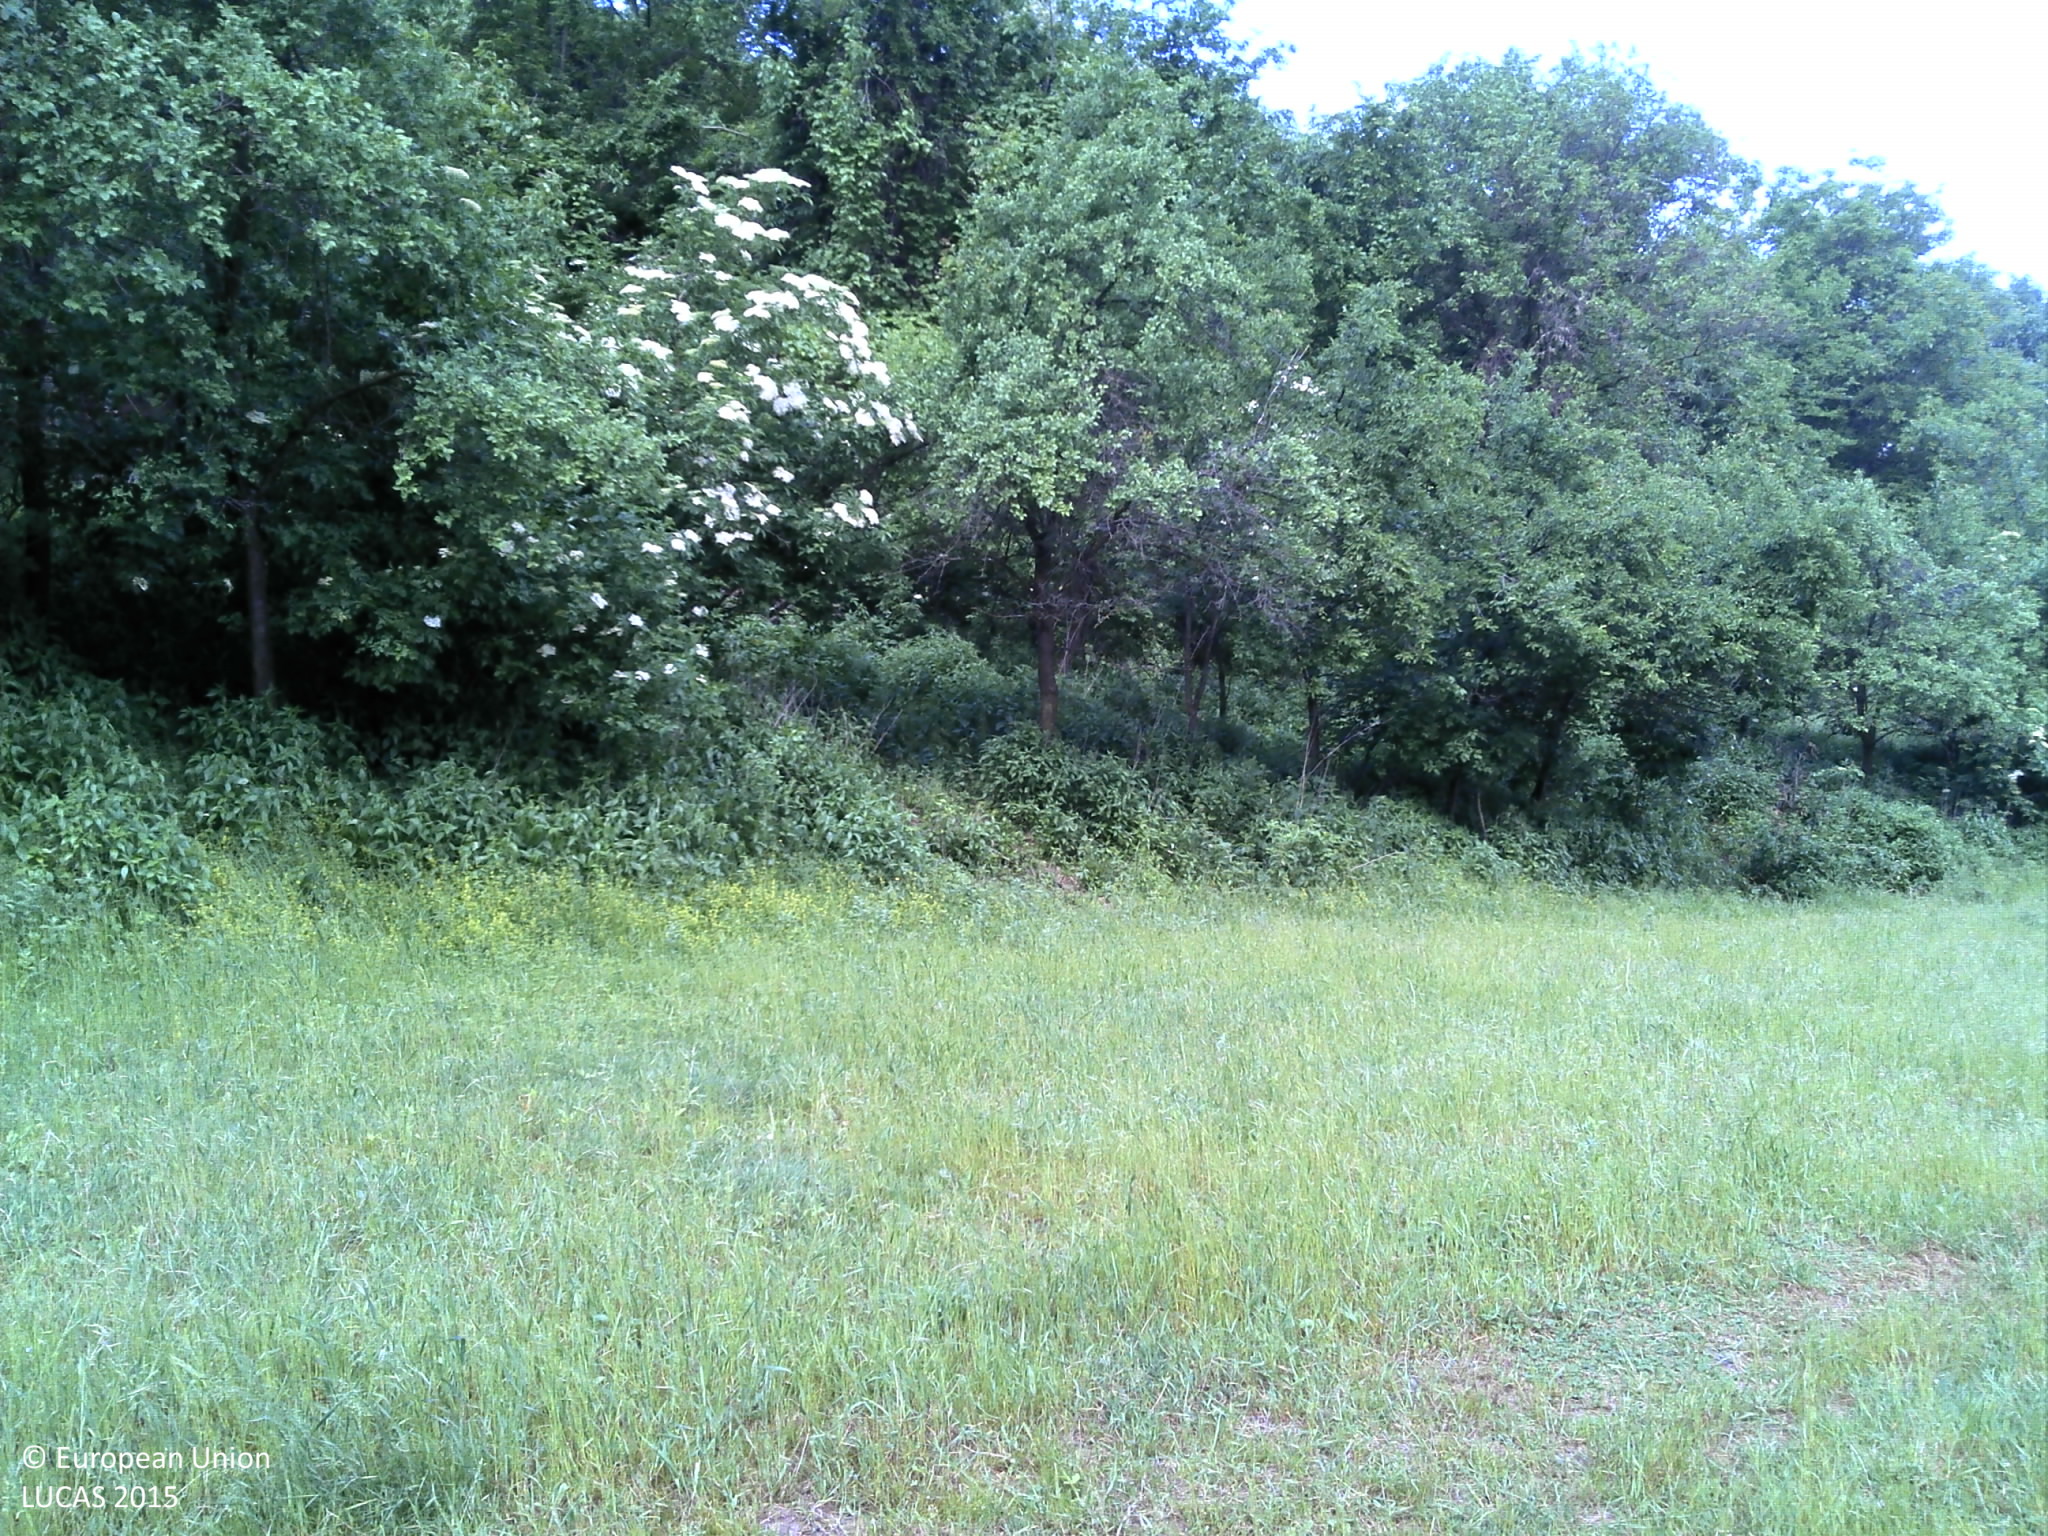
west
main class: Grassland
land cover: Grassland without tree/shrub cover
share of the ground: > 75 %
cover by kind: herbaceous plants 100 %
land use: Agriculture (excluding fallow land and kitchen gardens)
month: May
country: HR
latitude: 45.8154
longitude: 18.6959
